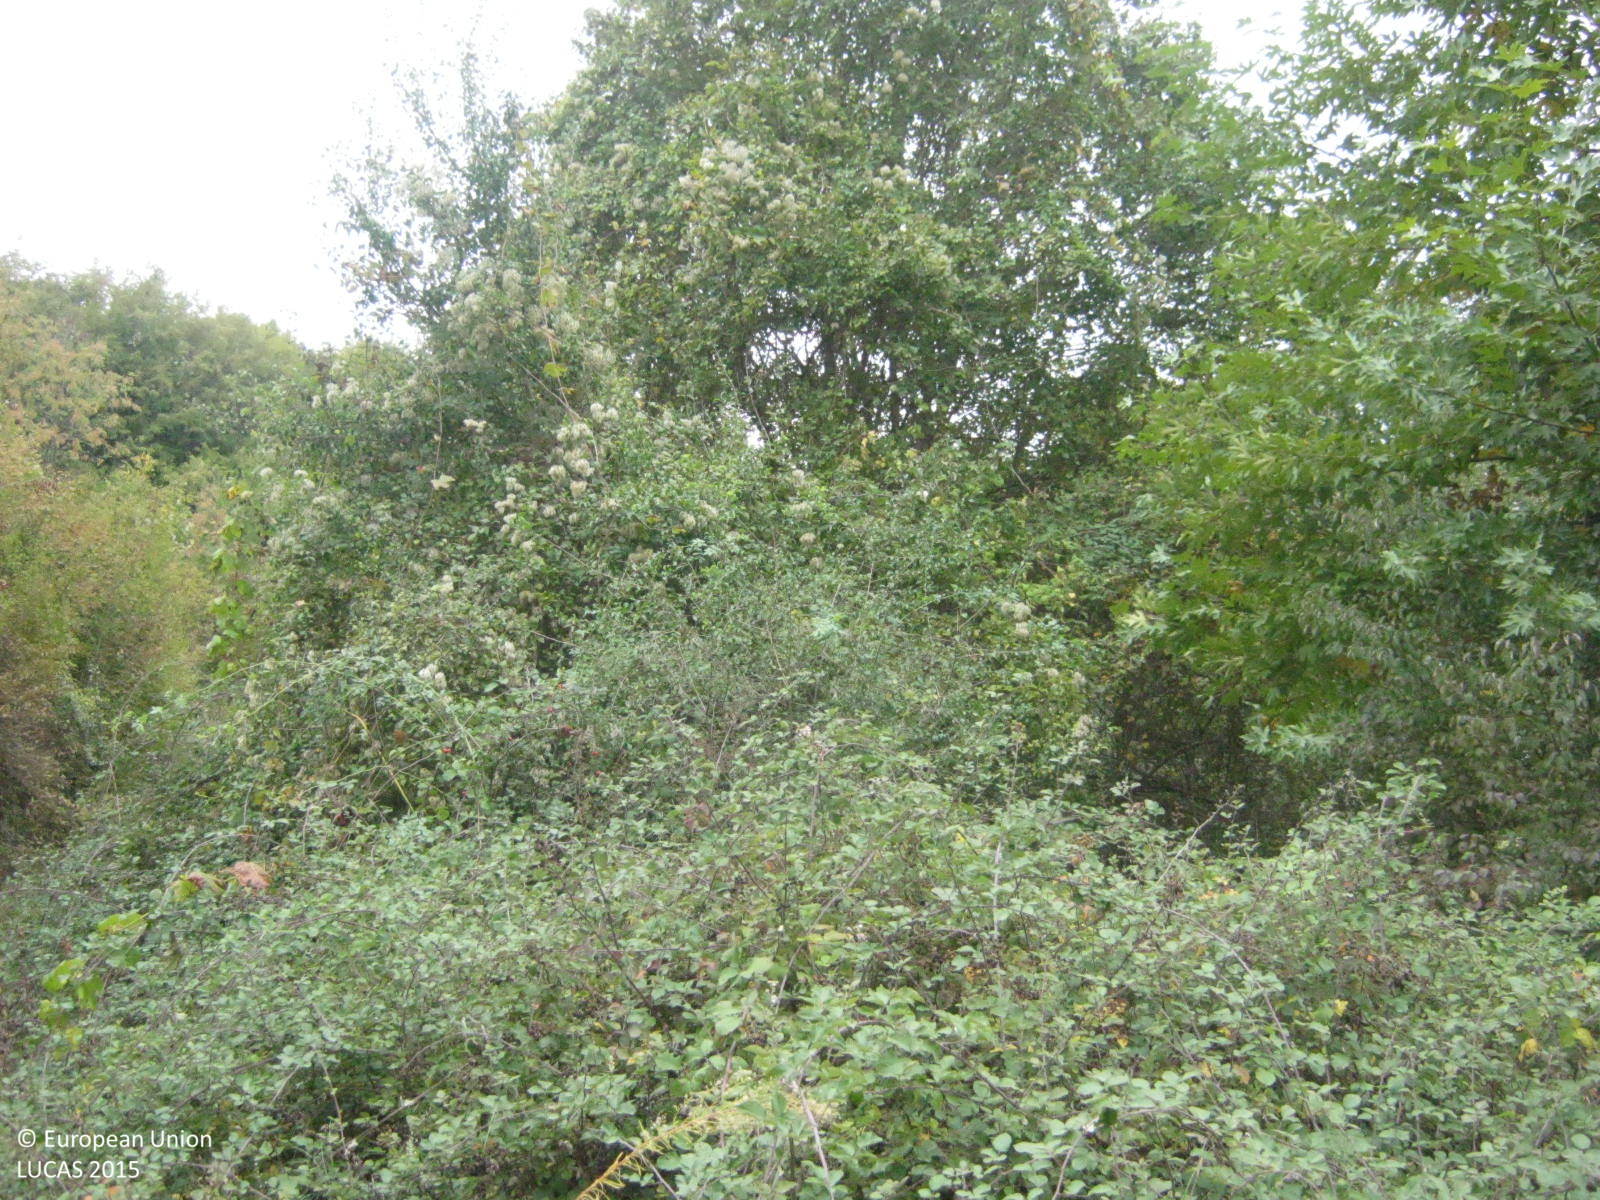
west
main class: Woodland
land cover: Broadleaved woodland
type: thermophilous deciduous forest
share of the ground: 50 - 75 %
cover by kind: broadleaved forest trees 55 %, herbaceous plants 25 %, unconsolidated bare surface 15 %, shrubs 5 %
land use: Semi-natural and natural areas not in use
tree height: > 5 m
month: October
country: GR
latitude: 41.0605
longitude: 23.0189
